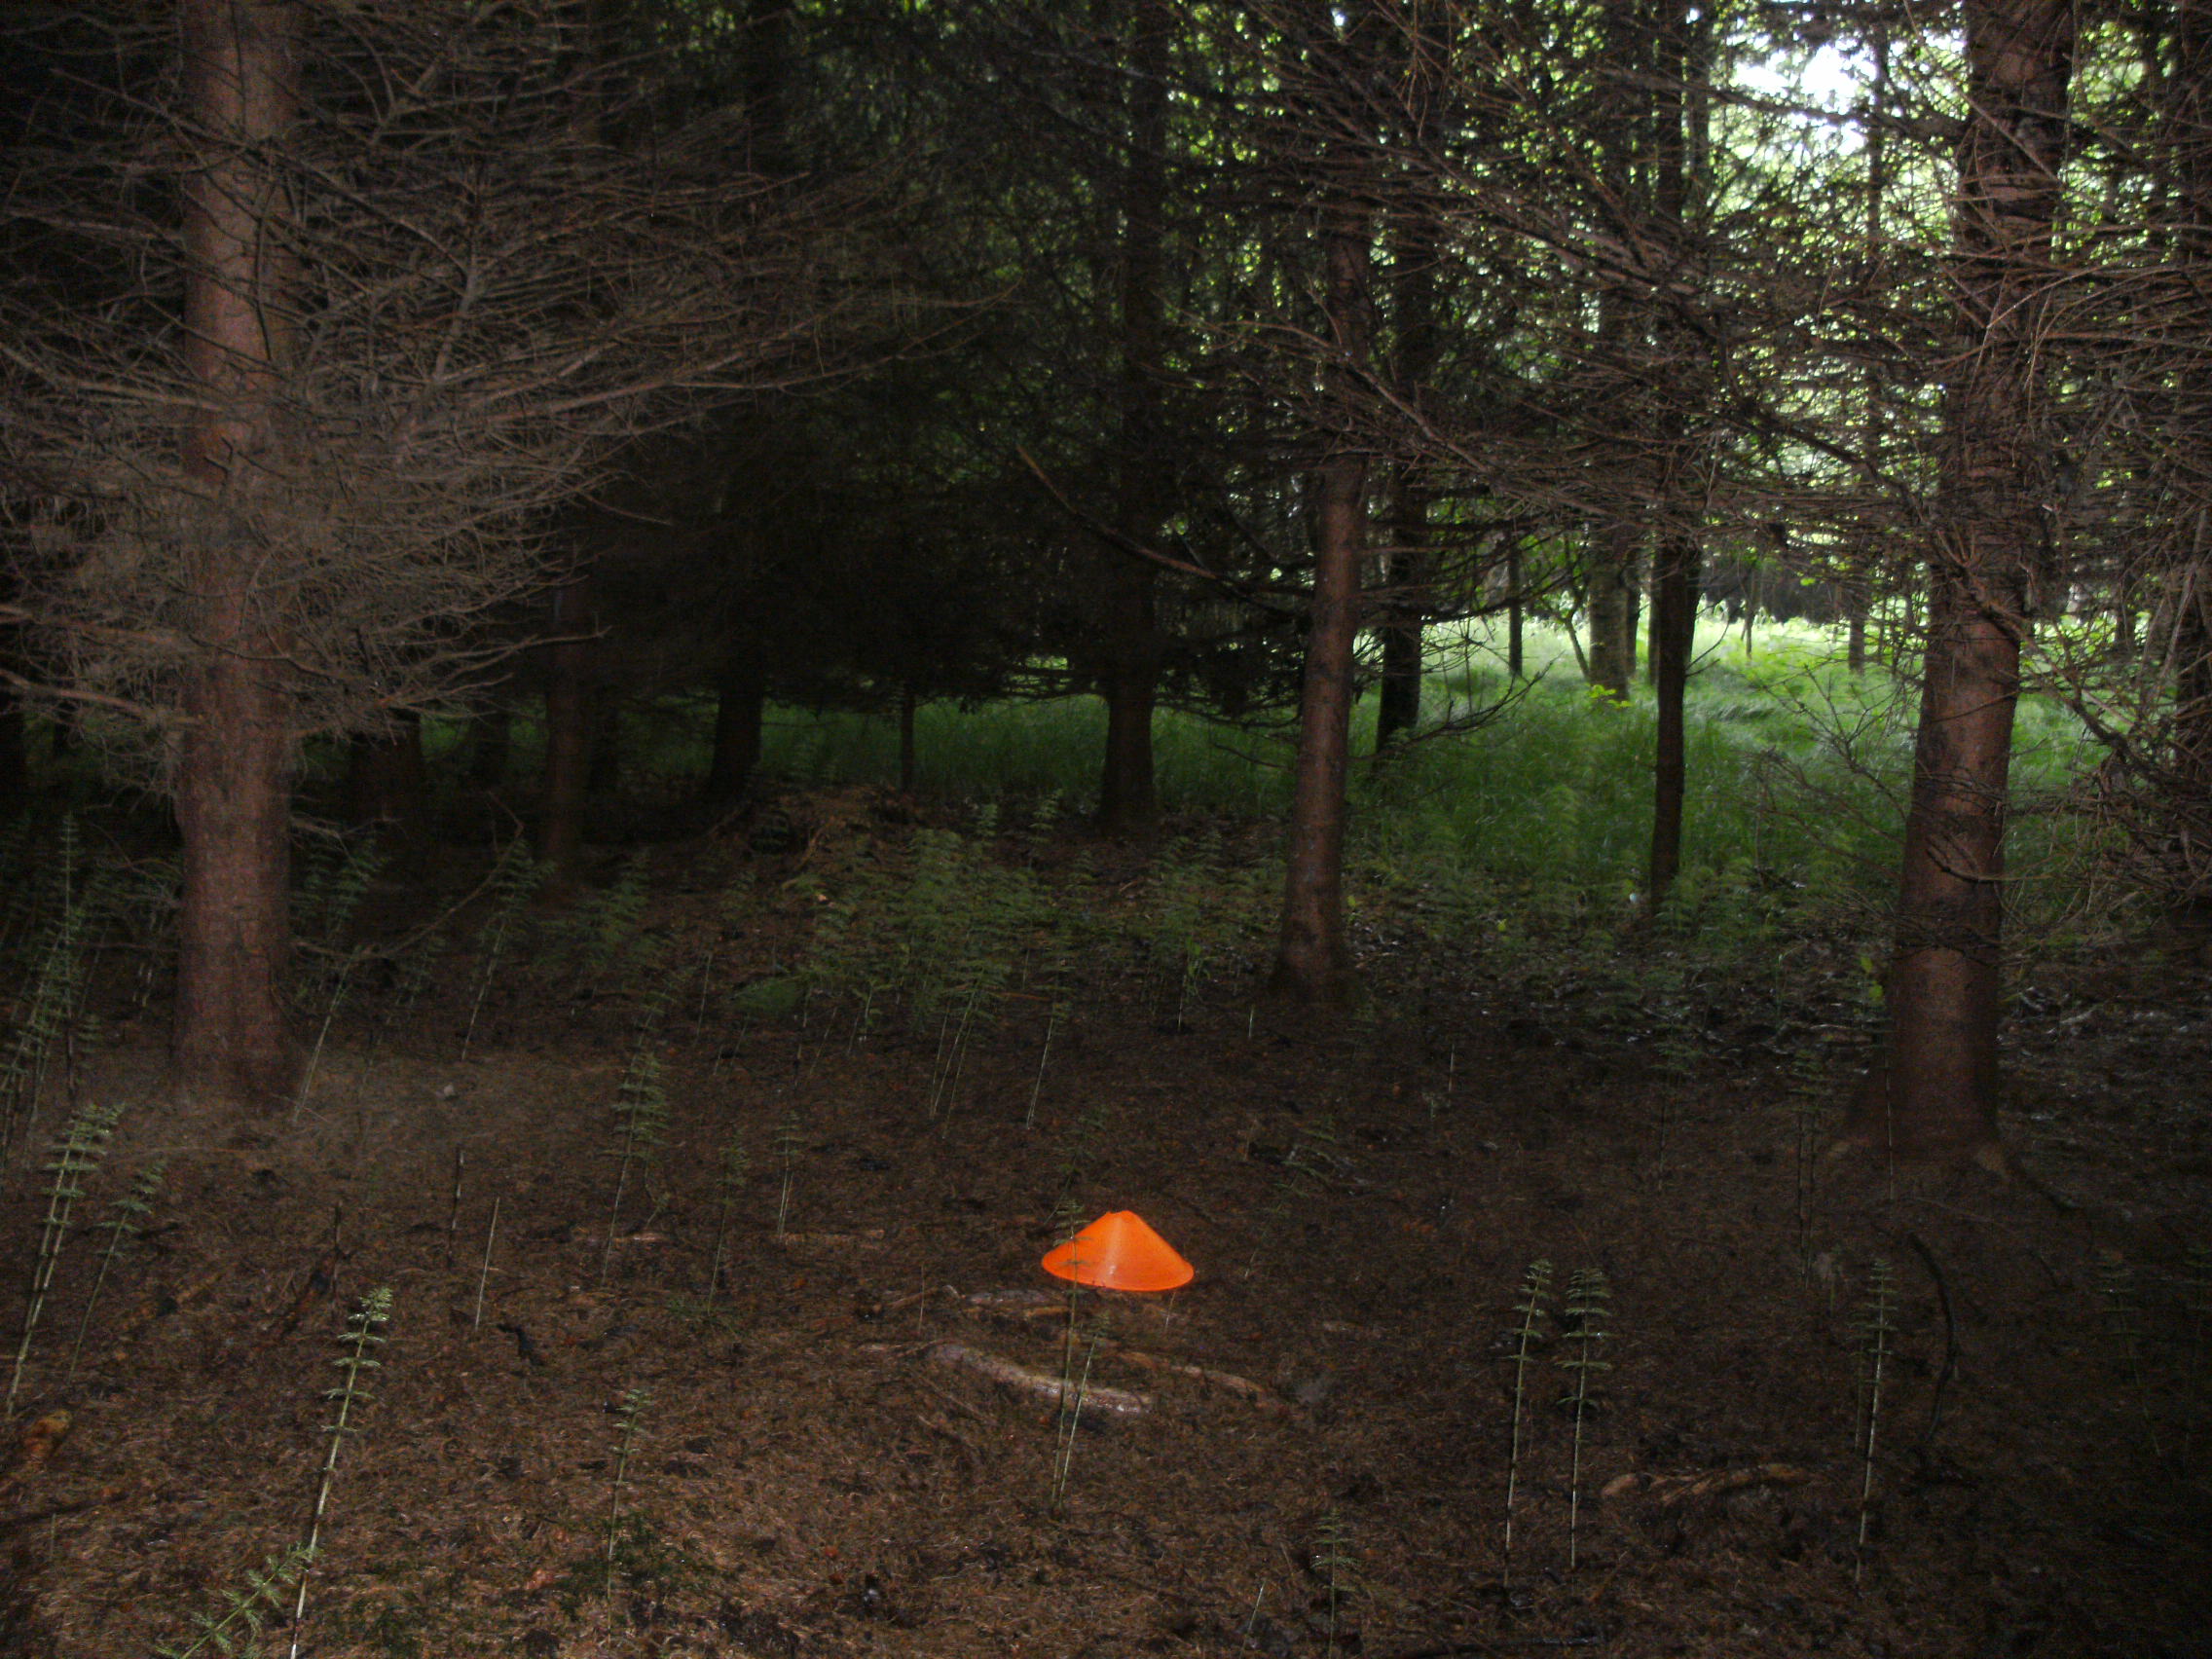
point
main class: Woodland
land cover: Spruce dominated coniferous woodland
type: hemiboreal forest and nemoral coniferous forest and mixed broadleaved-coniferous forest
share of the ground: > 75 %
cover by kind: coniferous forest trees 95 %, unconsolidated bare surface 5 %
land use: Forestry
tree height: > 5 m
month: May
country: AT
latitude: 48.4031
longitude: 13.4710
